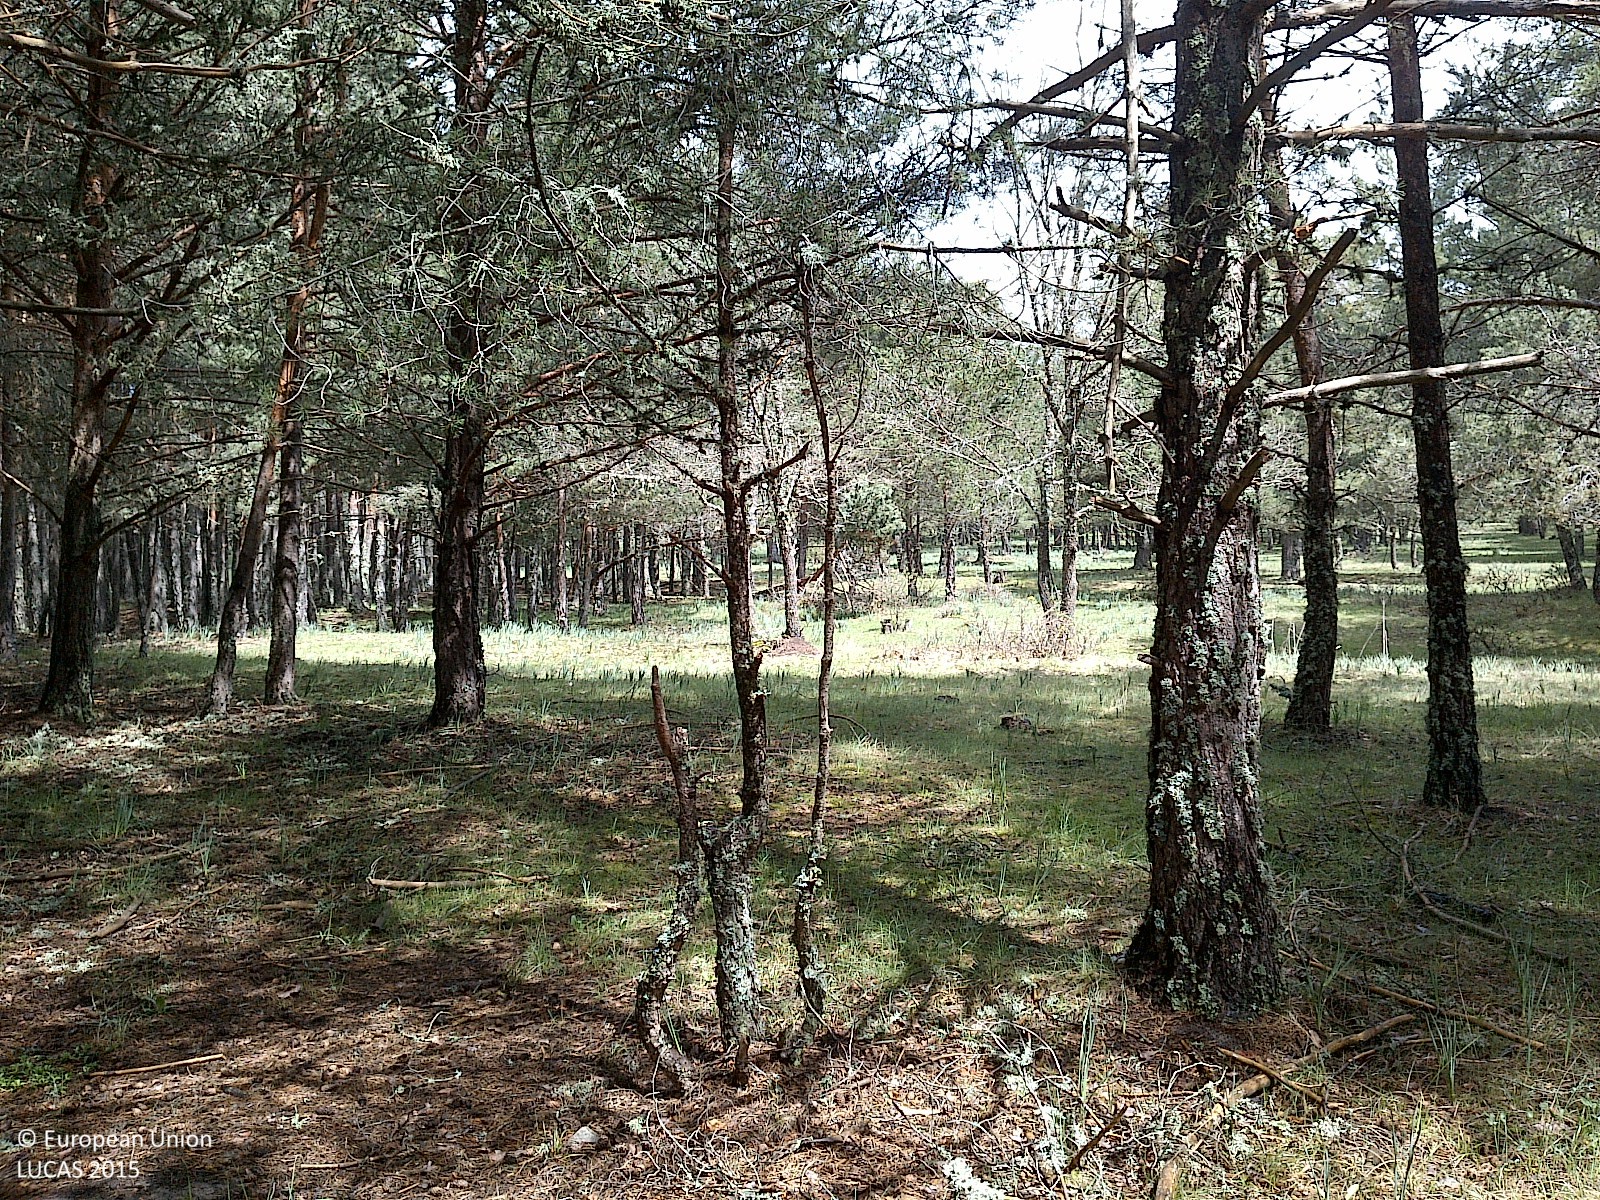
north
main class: Woodland
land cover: Pine dominated coniferous woodland
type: coniferous forest of the mediterranean region
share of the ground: > 75 %
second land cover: Grassland without tree/shrub cover
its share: 50 - 75 %
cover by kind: coniferous forest trees 85 %, herbaceous plants 15 %
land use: Forestry
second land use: Agriculture (excluding fallow land and kitchen gardens)
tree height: > 5 m
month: April
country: ES
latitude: 41.8180
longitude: -2.8156
